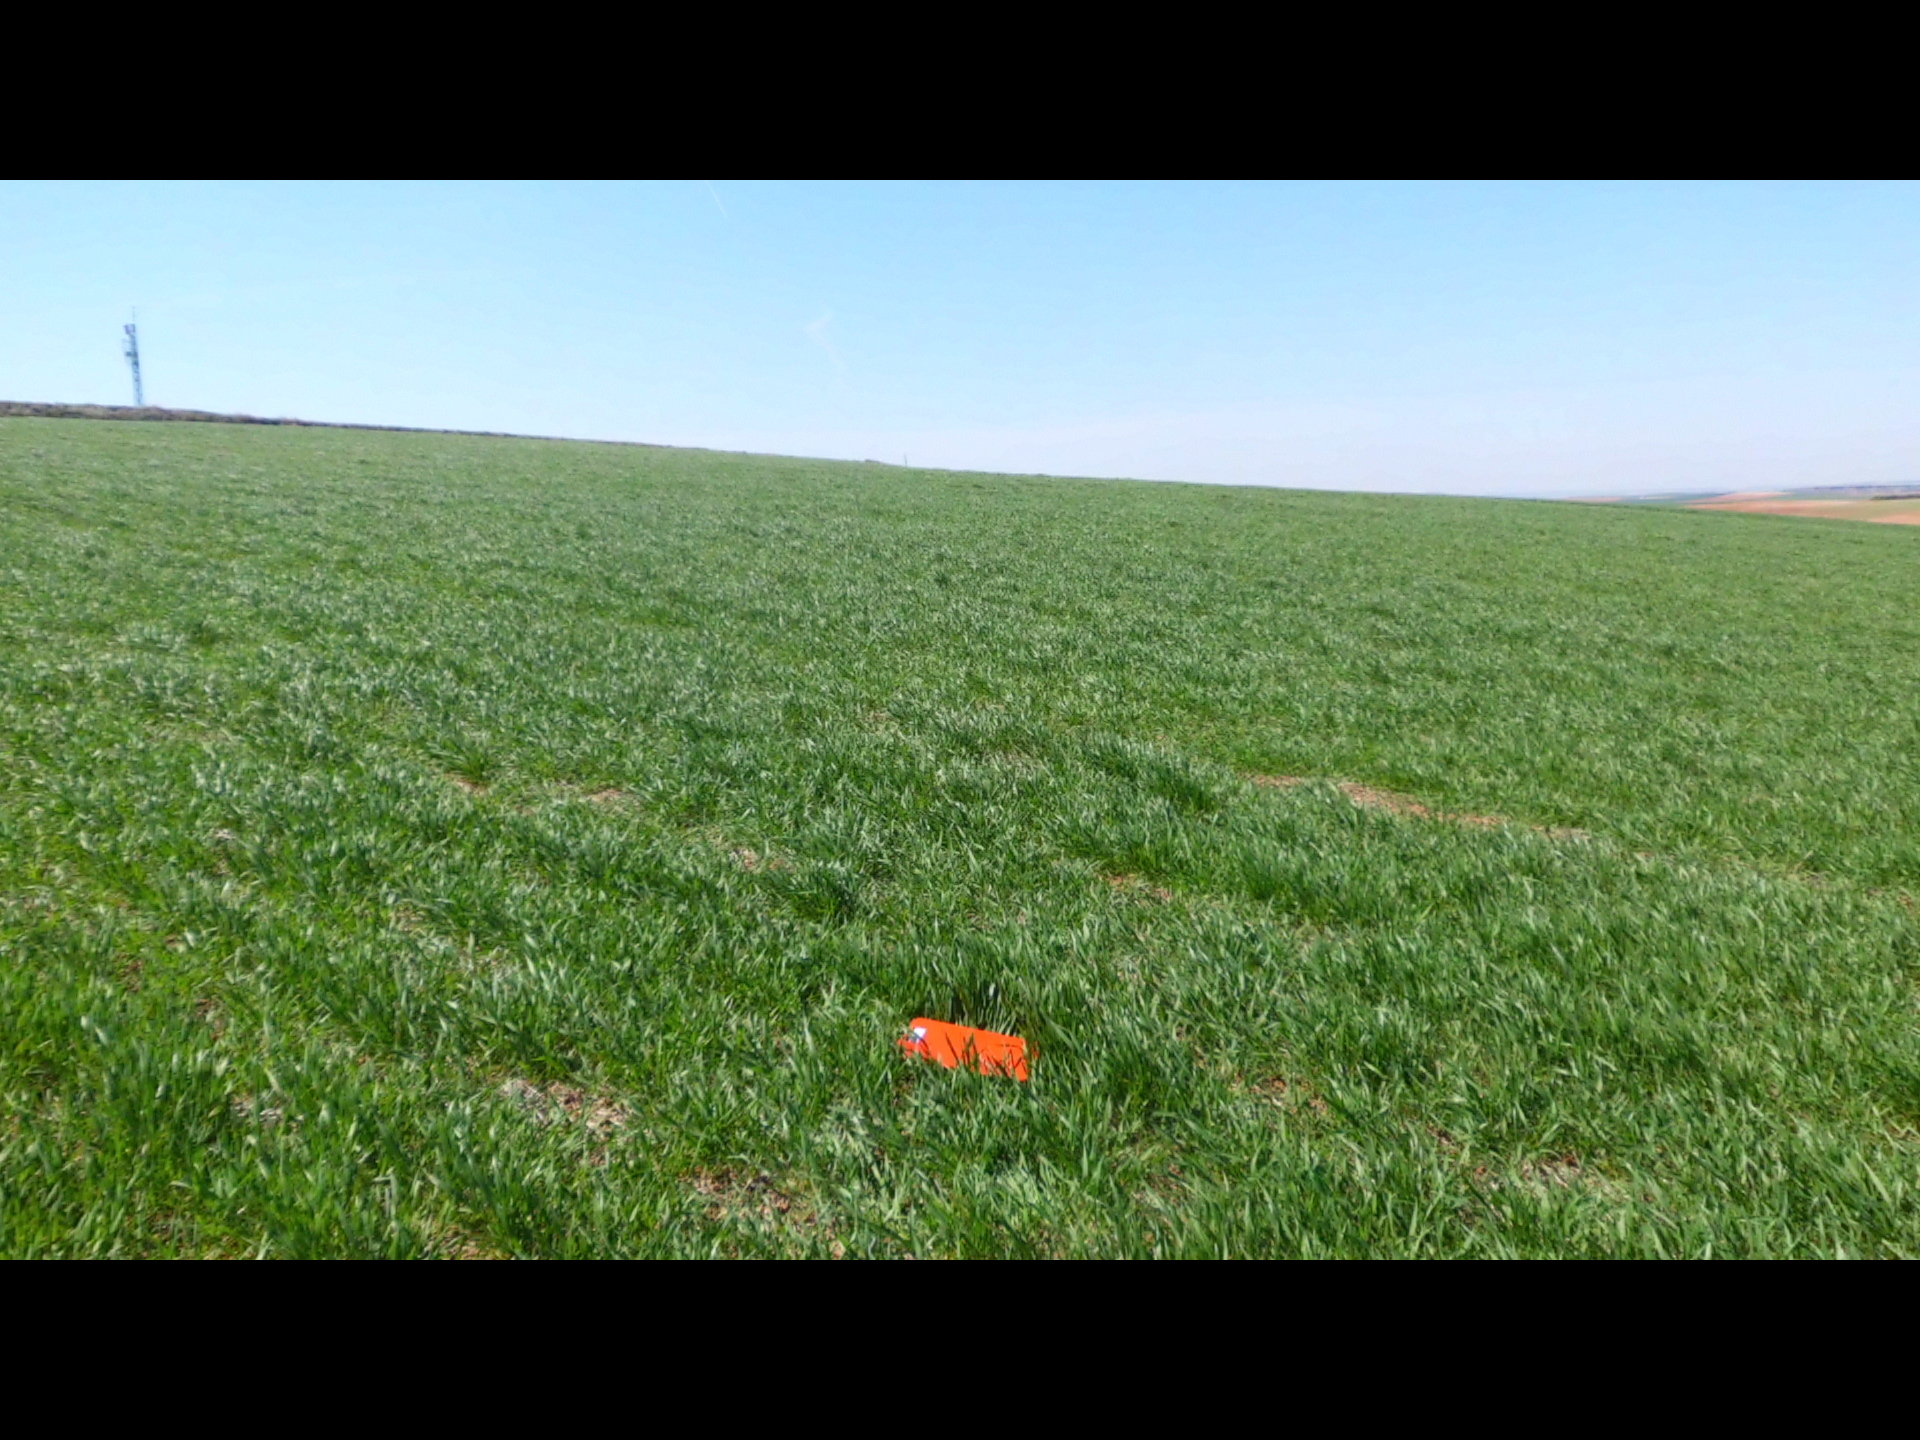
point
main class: Cropland
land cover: Common wheat
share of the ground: > 75 %
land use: Agriculture (excluding fallow land and kitchen gardens)
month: April
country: ES
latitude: 42.1831
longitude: -3.7778
